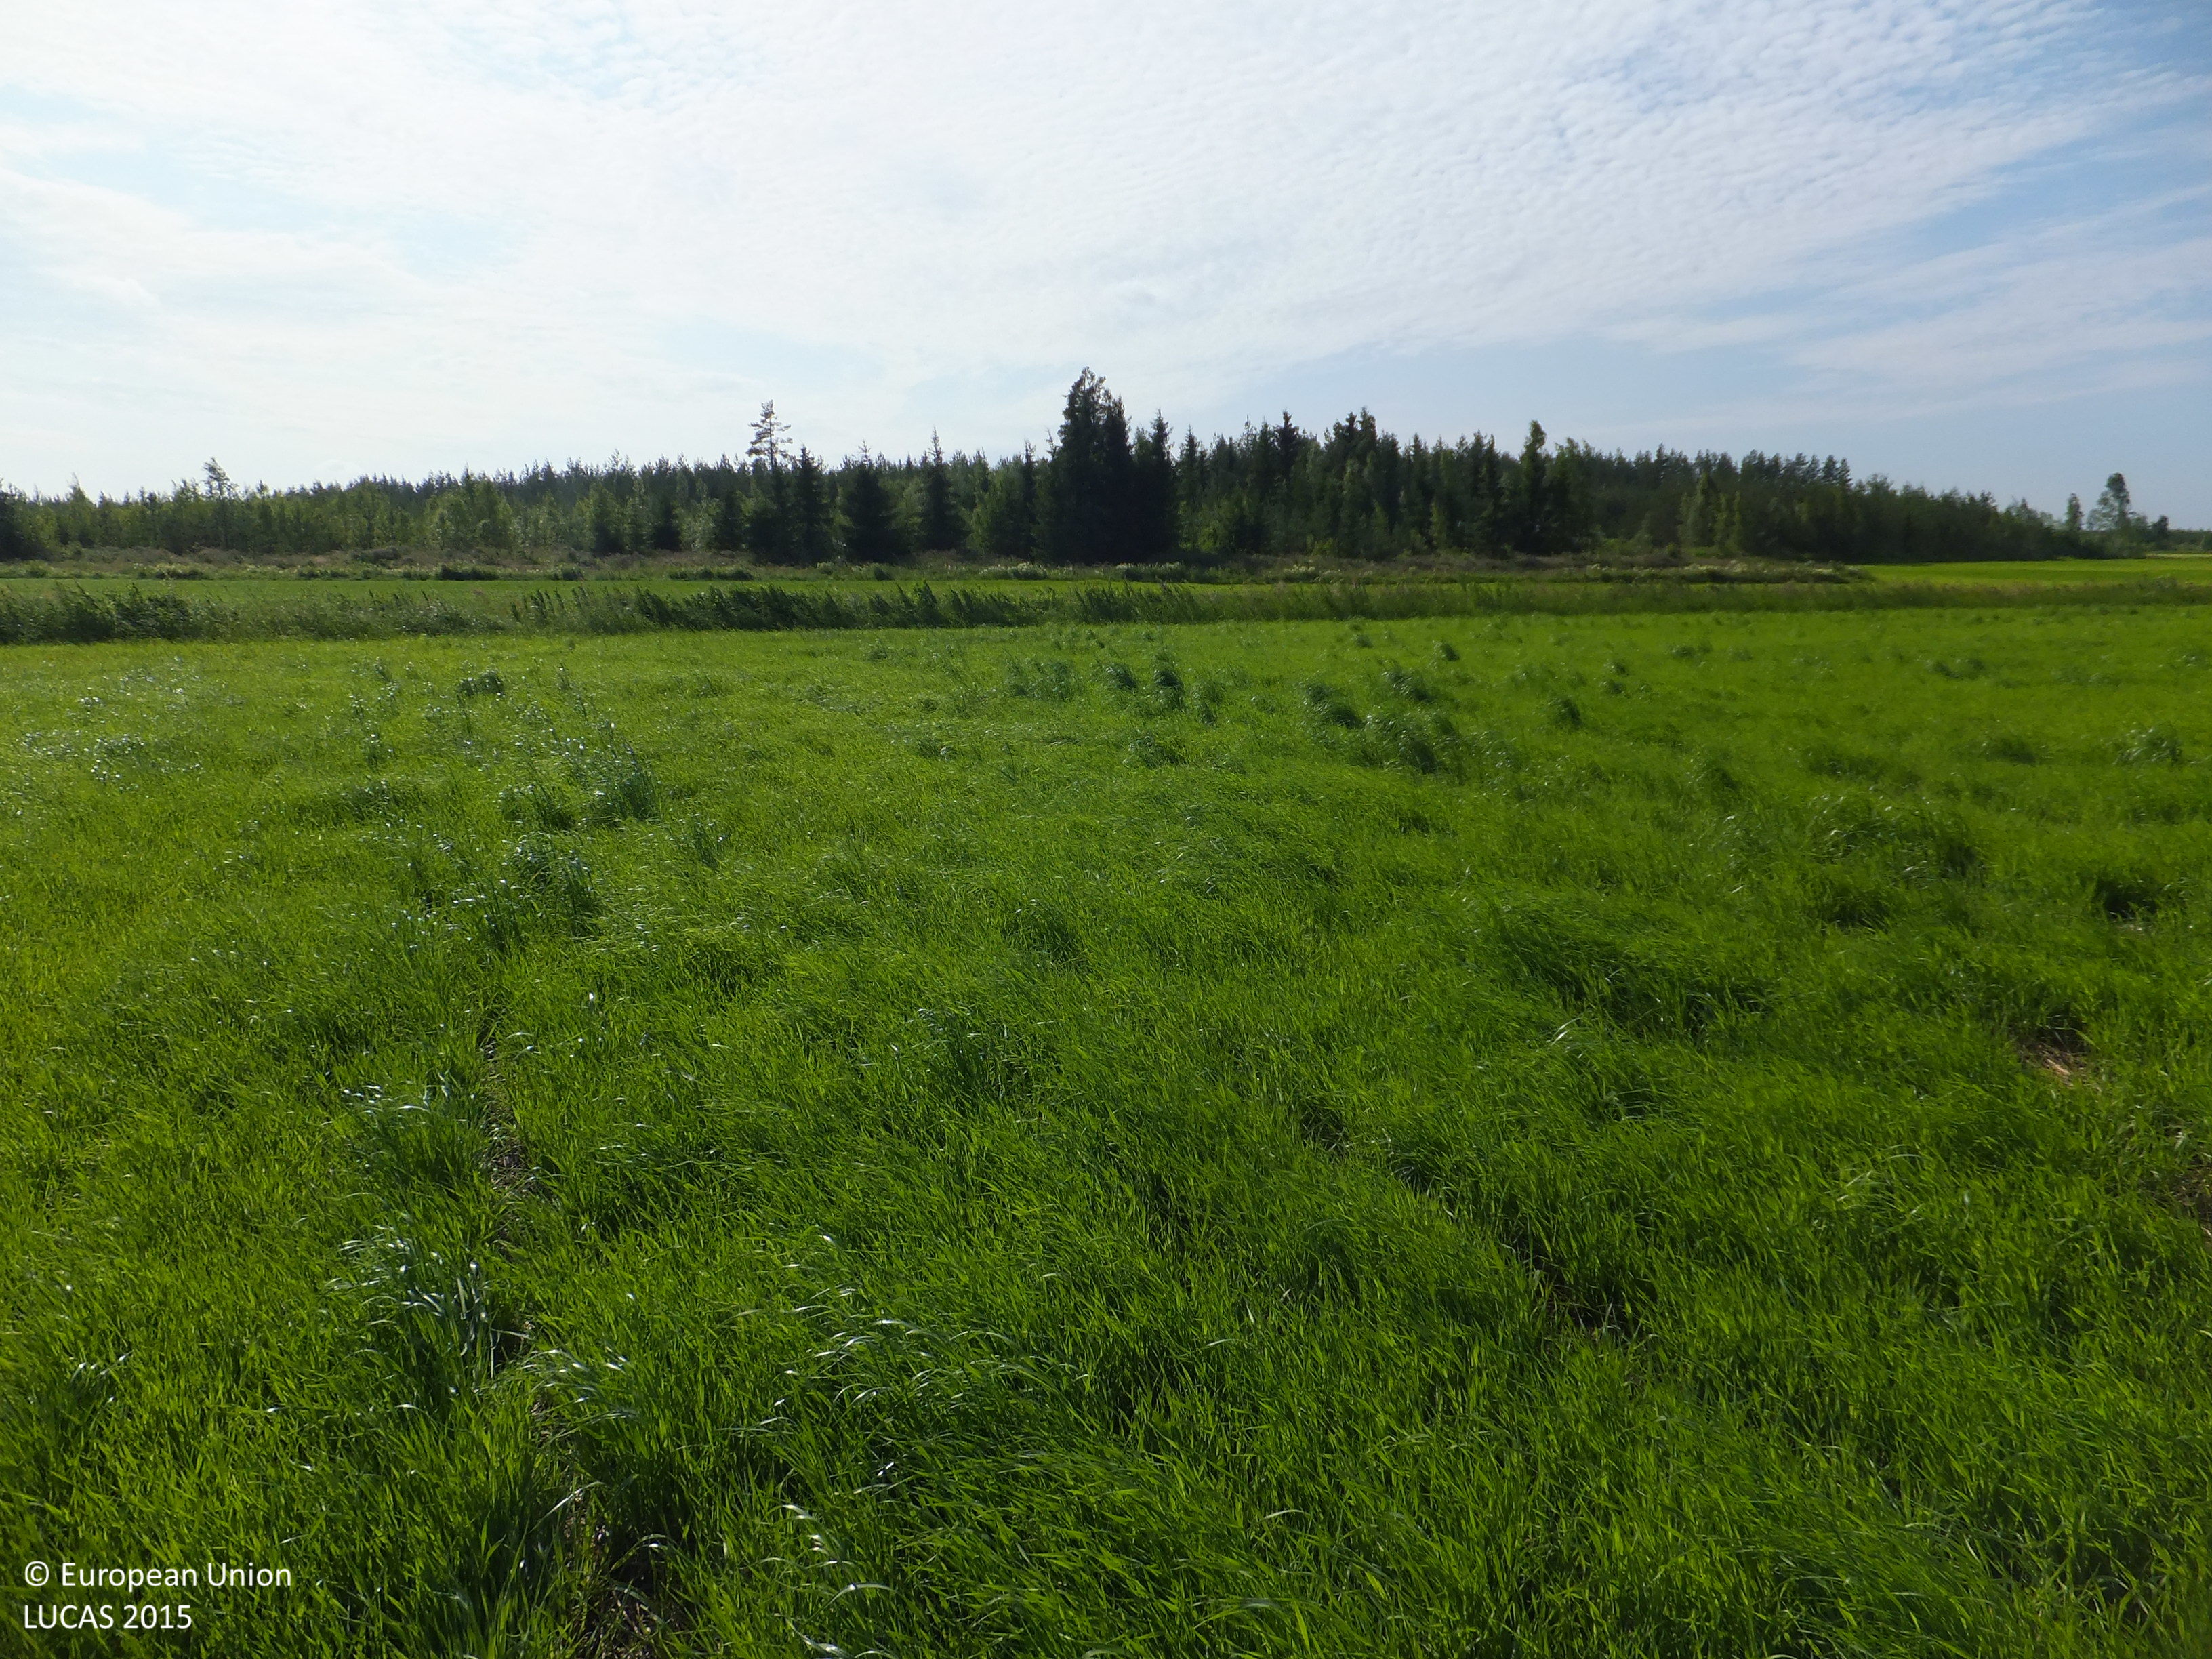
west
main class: Cropland
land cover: Temporary grasslands
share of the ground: > 75 %
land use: Agriculture (excluding fallow land and kitchen gardens)
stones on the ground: < 10 %
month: July
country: FI
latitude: 63.6345
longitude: 23.0719
